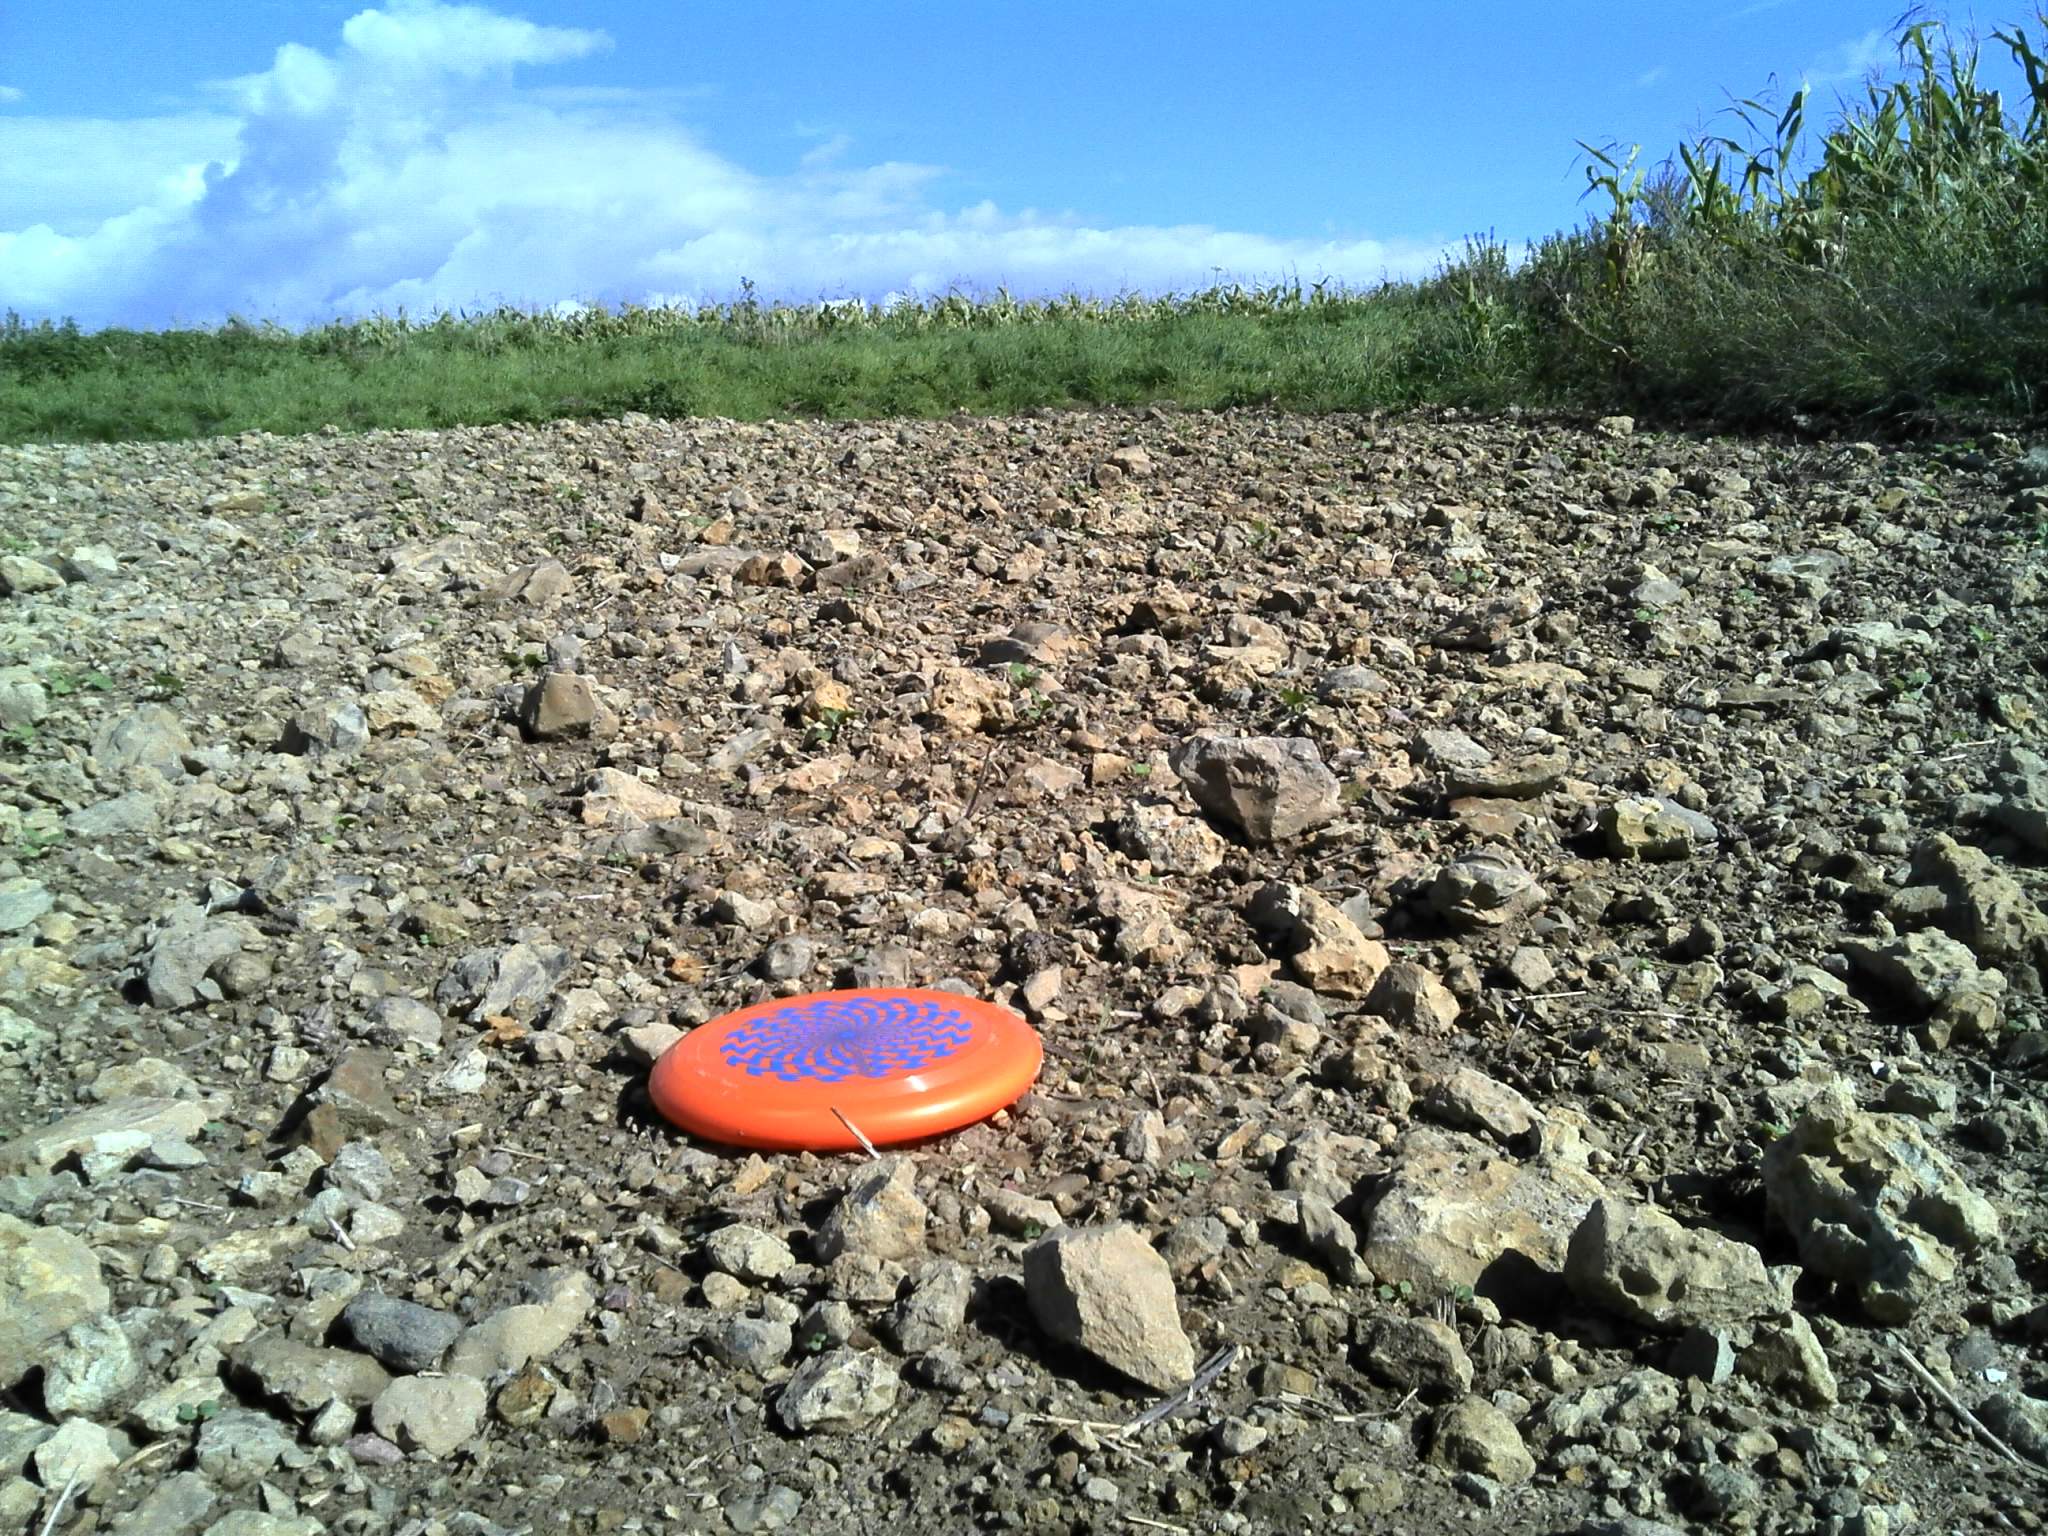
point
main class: Cropland
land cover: Other fibre and oleaginous crops
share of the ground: < 10 %
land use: Agriculture (excluding fallow land and kitchen gardens)
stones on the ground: > 50 %
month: September
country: FR
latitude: 47.6318
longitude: 0.3010
